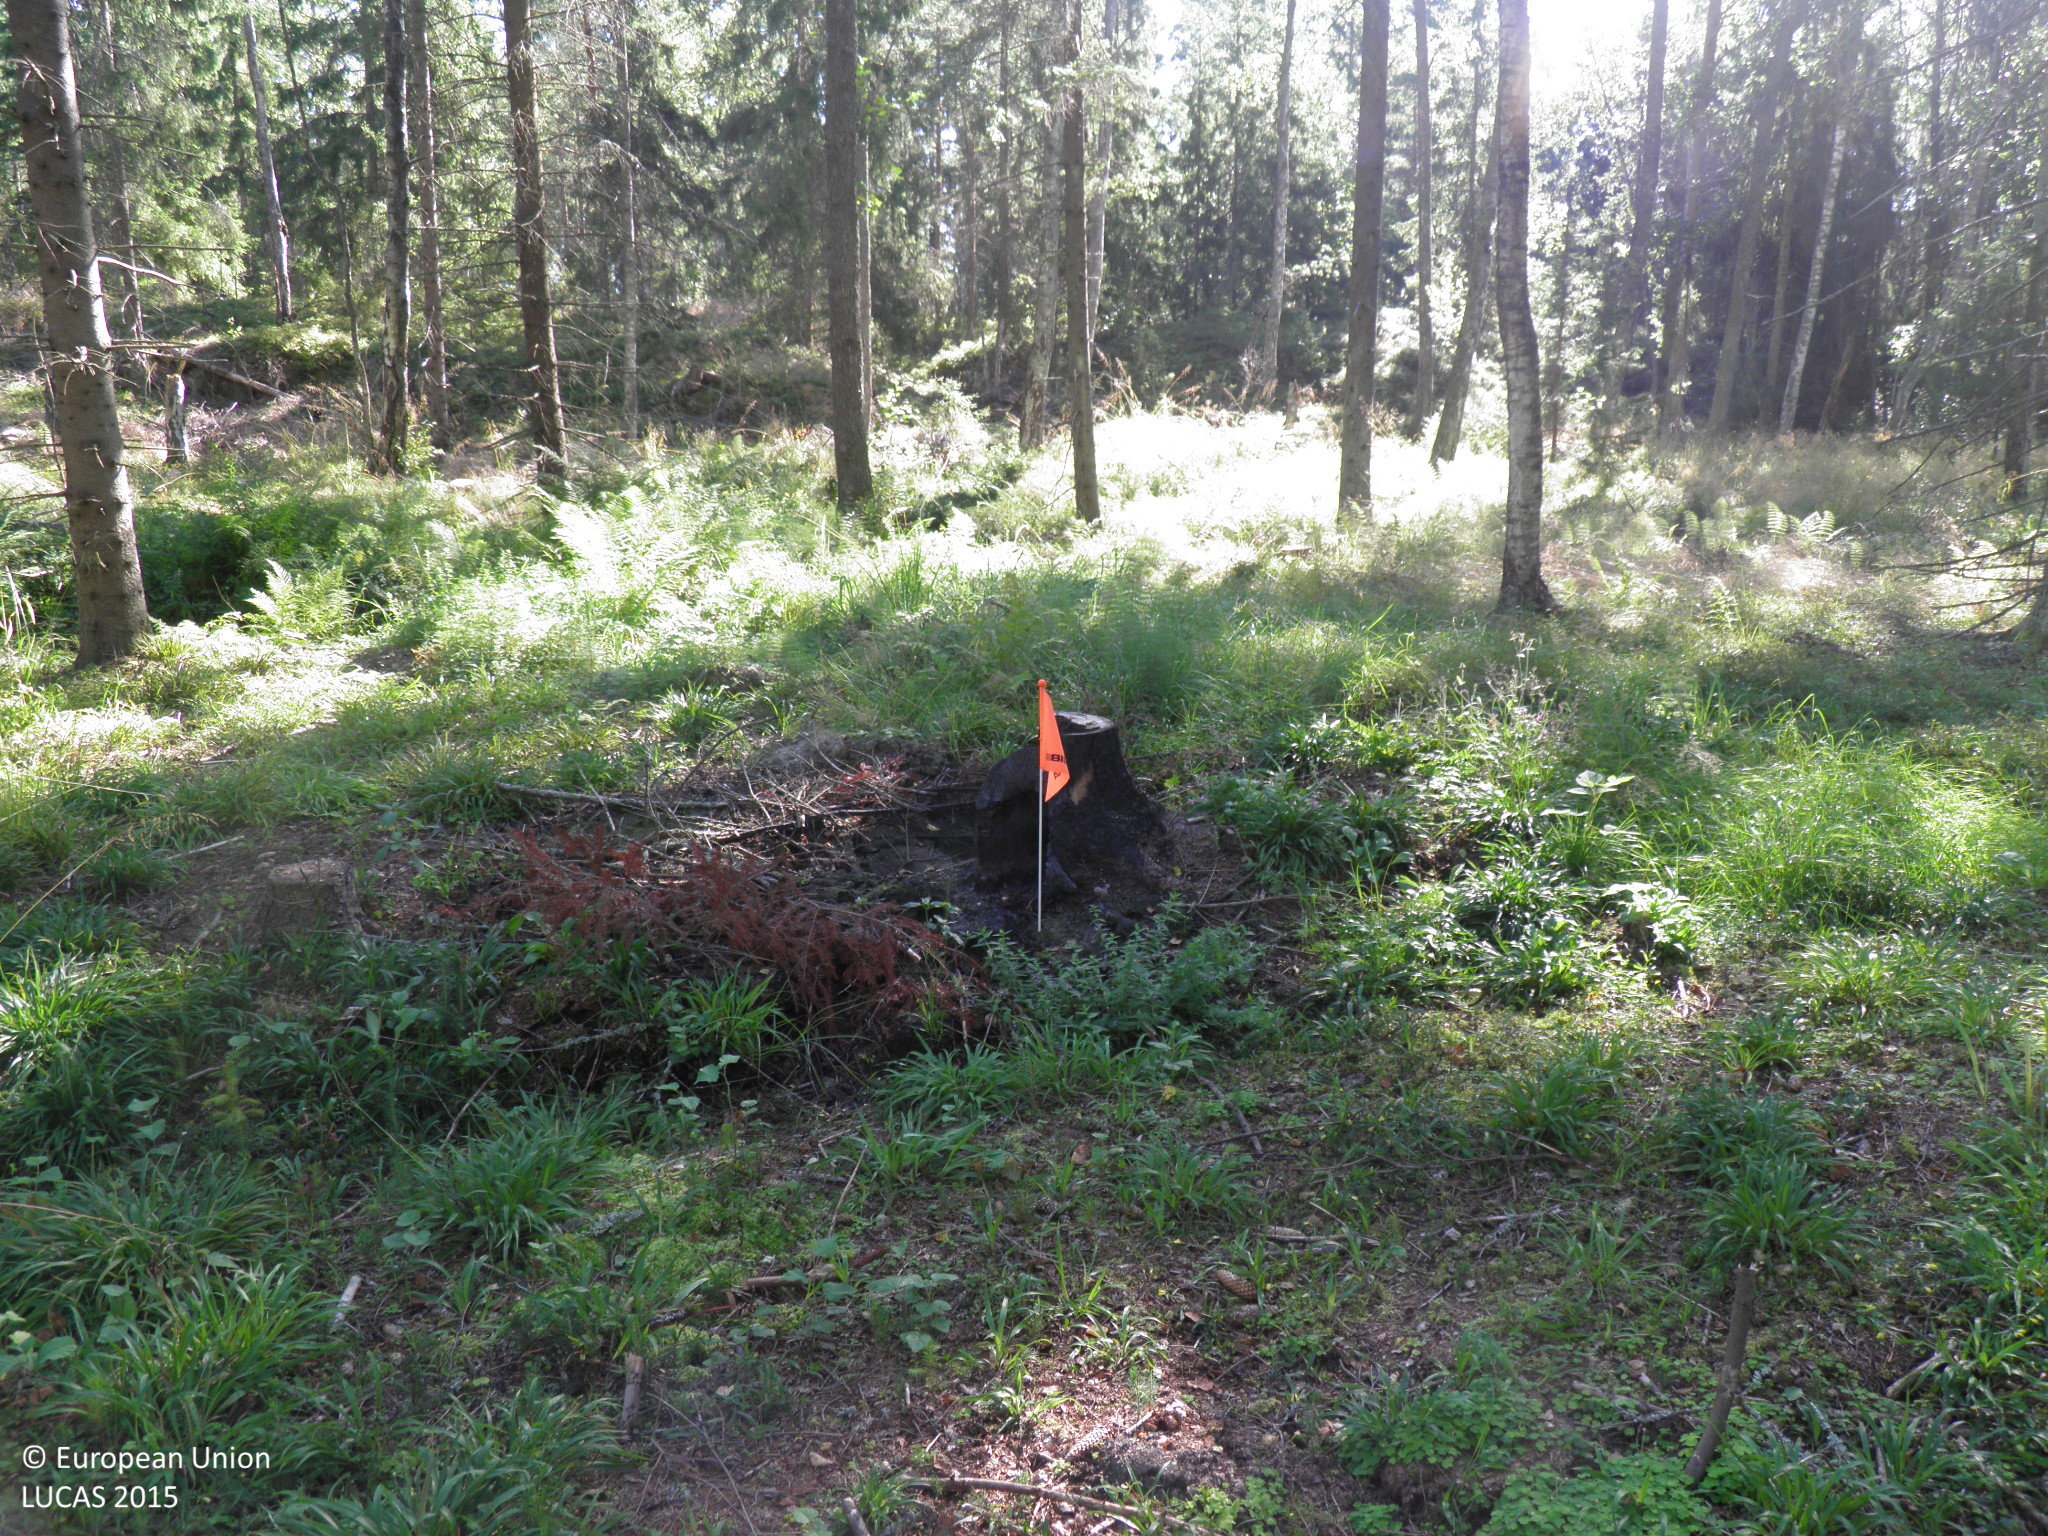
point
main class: Woodland
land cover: Other mixed woodland
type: hemiboreal forest and nemoral coniferous forest and mixed broadleaved-coniferous forest
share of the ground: 50 - 75 %
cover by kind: coniferous forest trees 30 %, herbaceous plants 30 %, broadleaved forest trees 20 %, shrubs 20 %
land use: Forestry
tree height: > 5 m
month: August
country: FI
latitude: 60.8220
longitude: 21.2502
